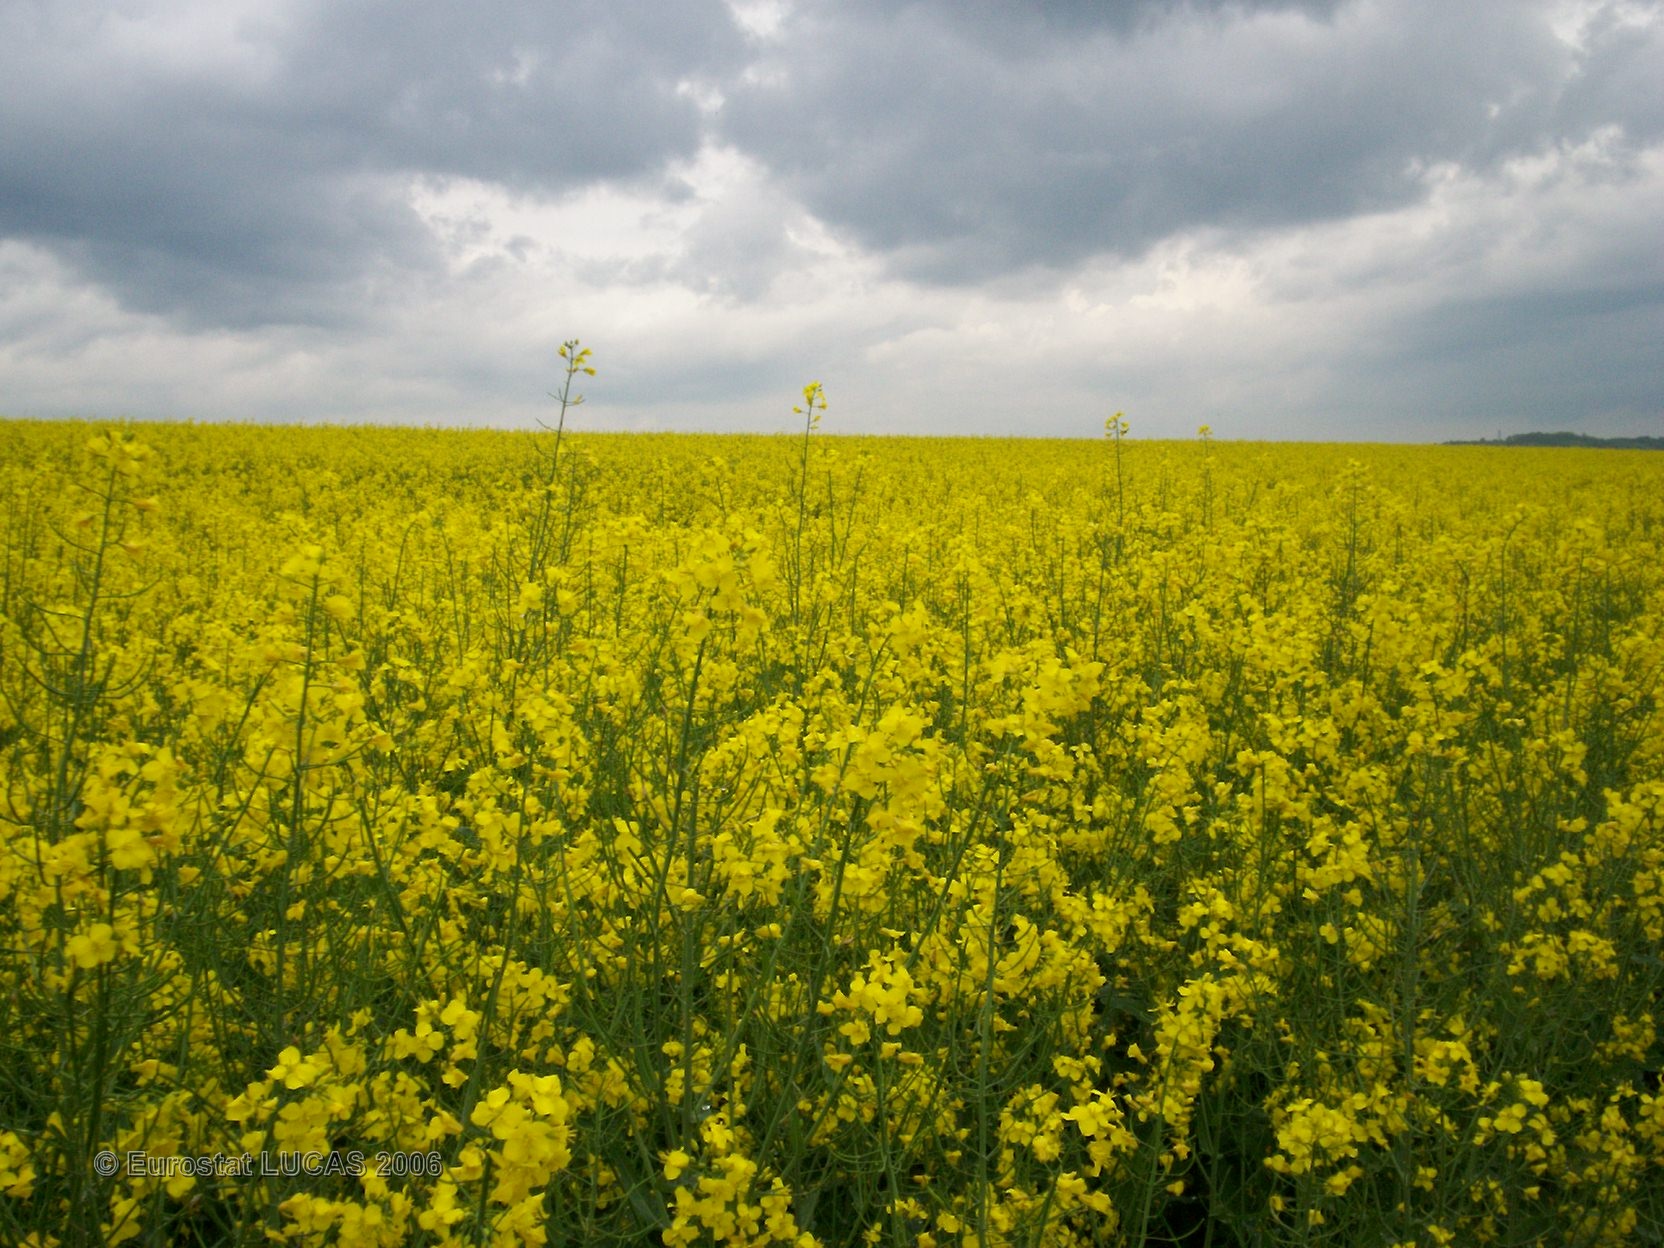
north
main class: Cropland
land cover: Rape and turnip rape
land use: Agriculture (excluding fallow land and kitchen gardens)
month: May
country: FR
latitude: 48.6555
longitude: 6.5387
